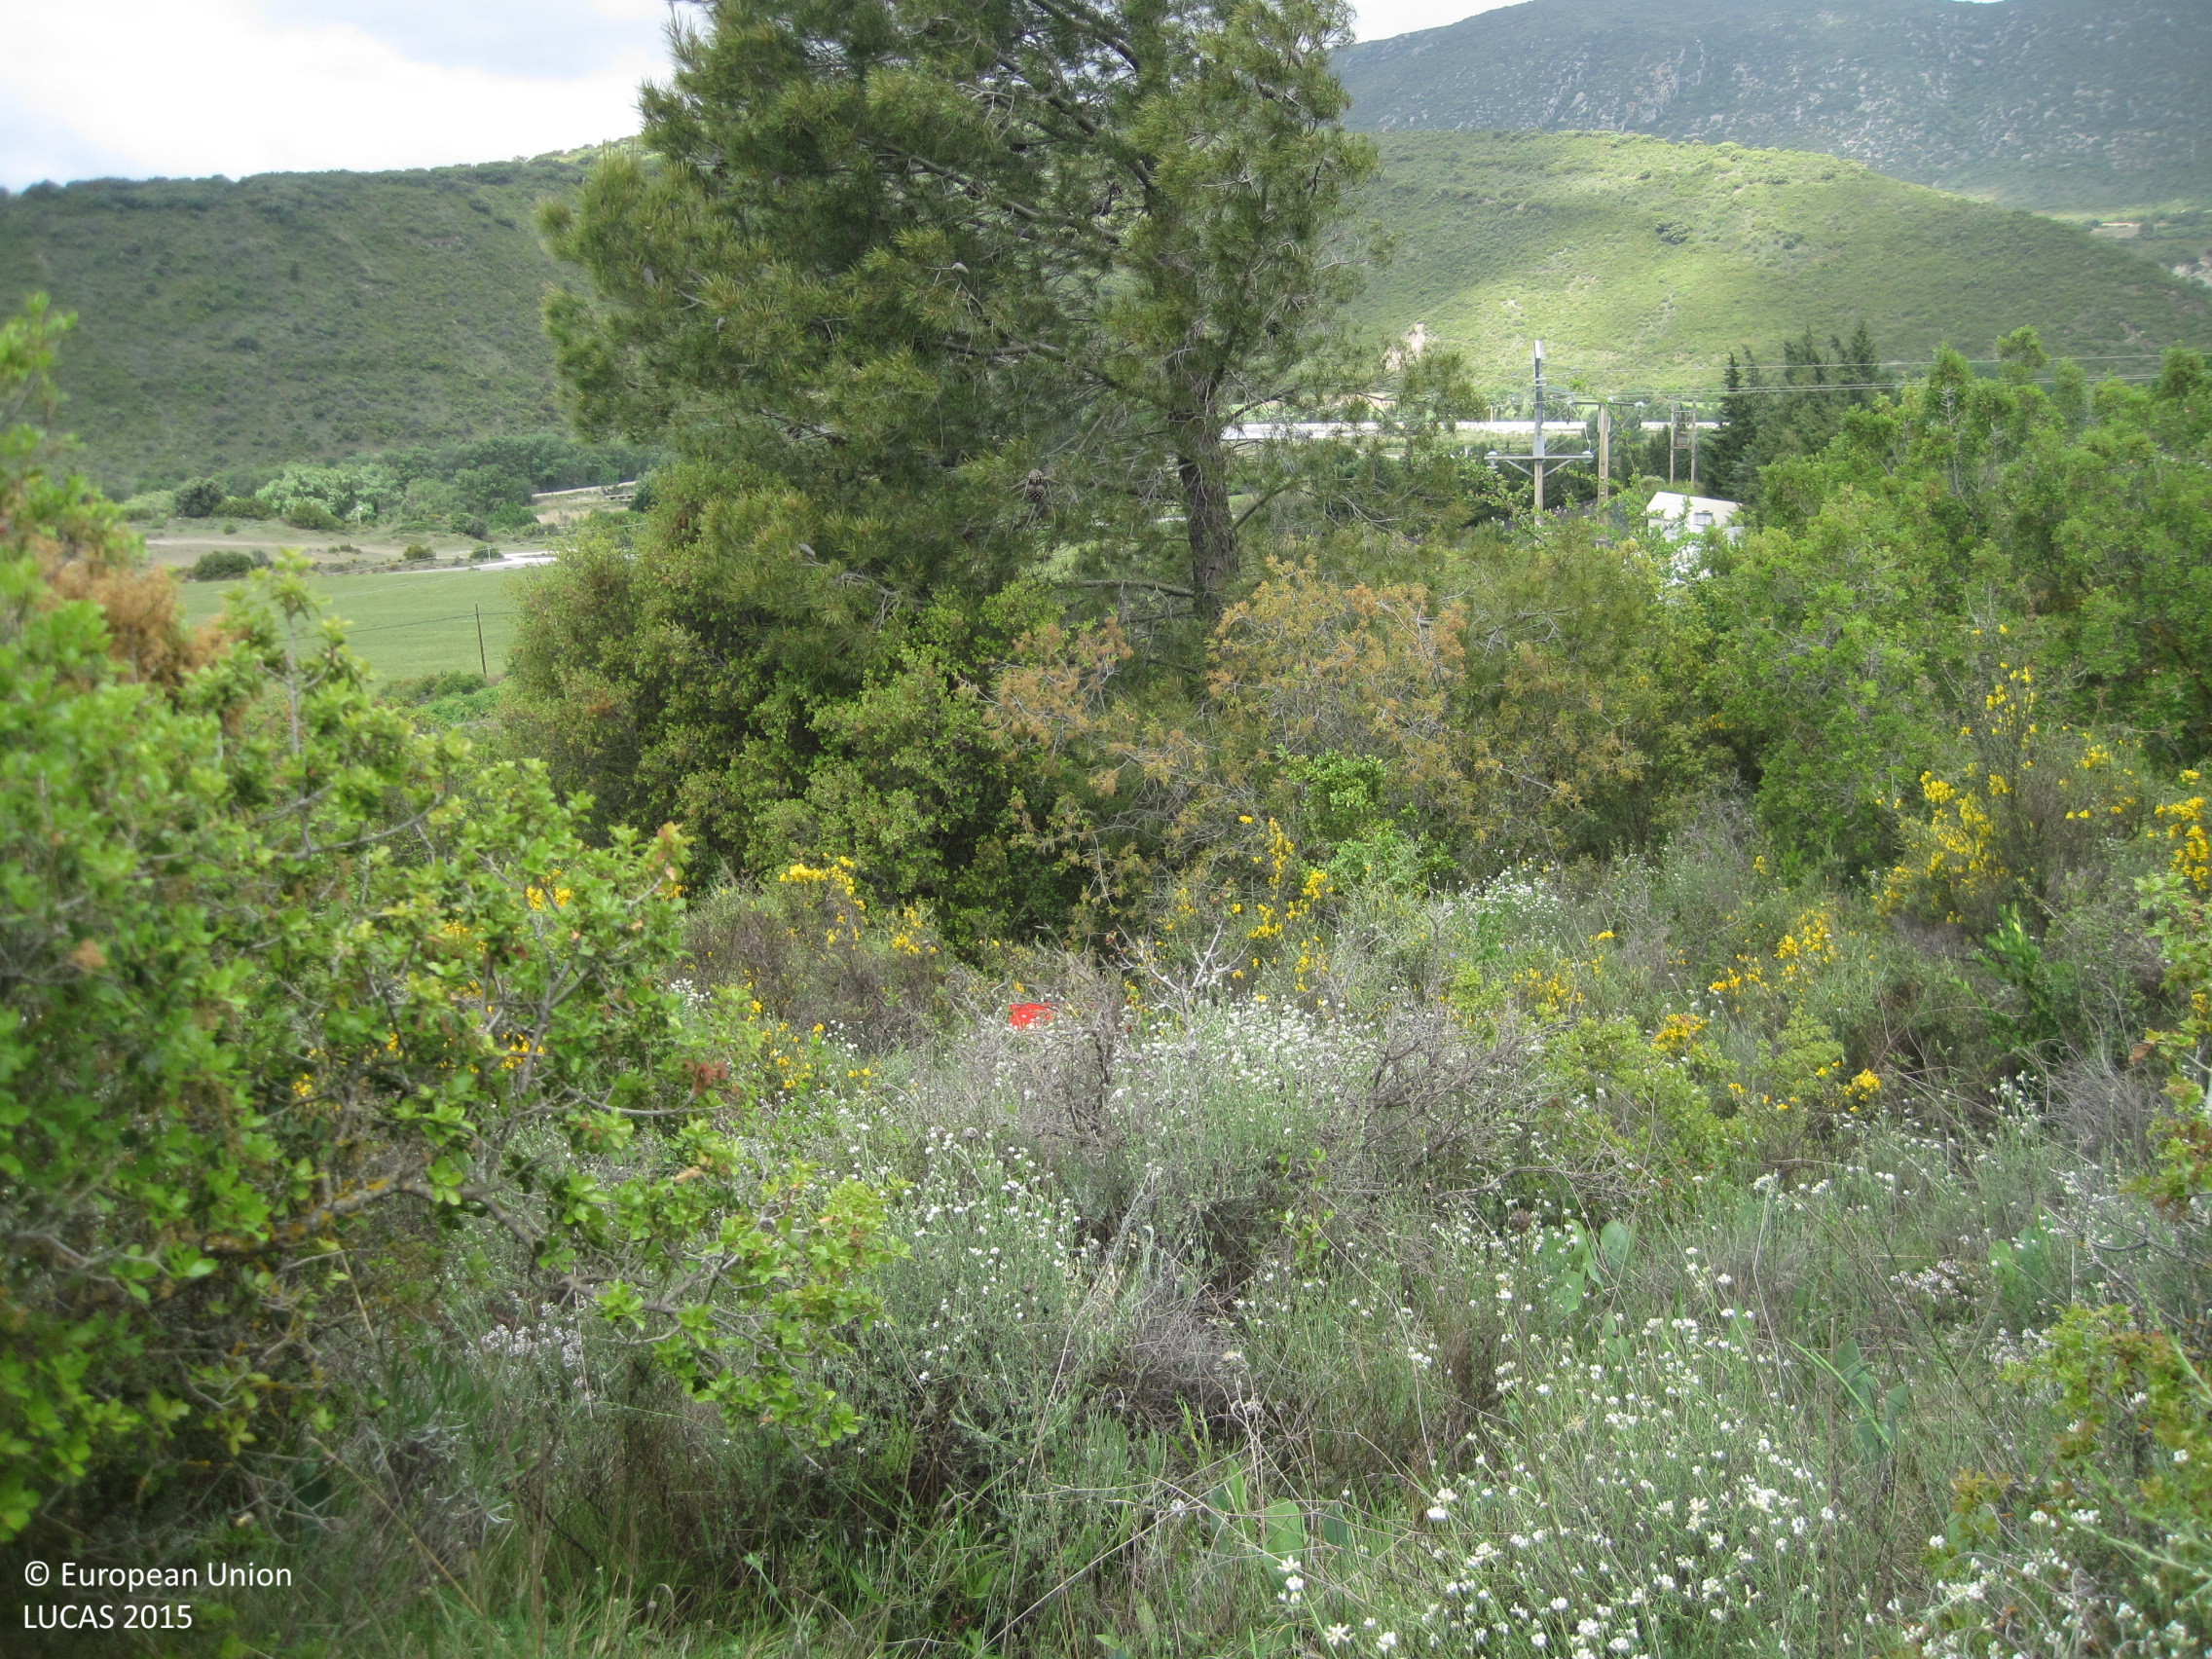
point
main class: Shrubland
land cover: Shrubland with sparse tree cover
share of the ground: > 75 %
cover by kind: shrubs 90 %, broadleaved forest trees 5 %, herbaceous plants 5 %
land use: Semi-natural and natural areas not in use
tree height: > 5 m
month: May
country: ES
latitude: 42.6124
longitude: -1.2117
